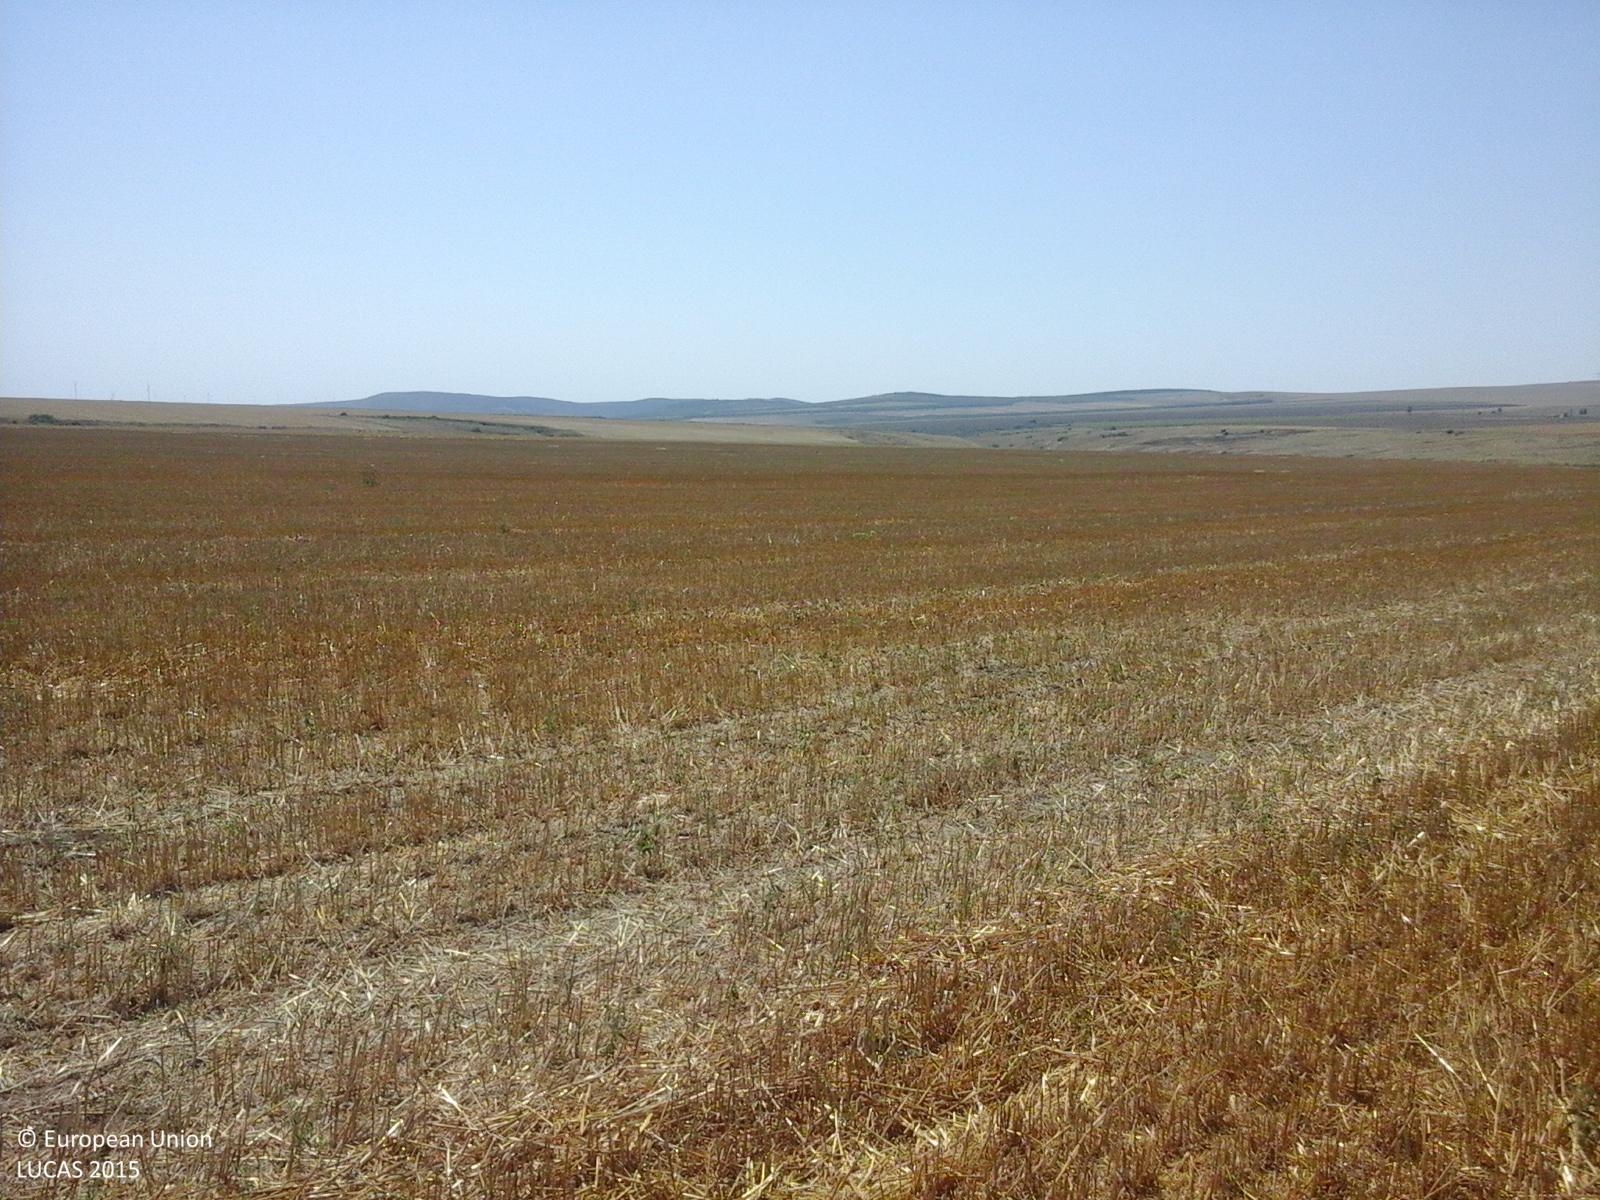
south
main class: Cropland
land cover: Common wheat
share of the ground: 50 - 75 %
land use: Agriculture (excluding fallow land and kitchen gardens)
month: August
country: RO
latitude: 44.5680
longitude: 28.2090
